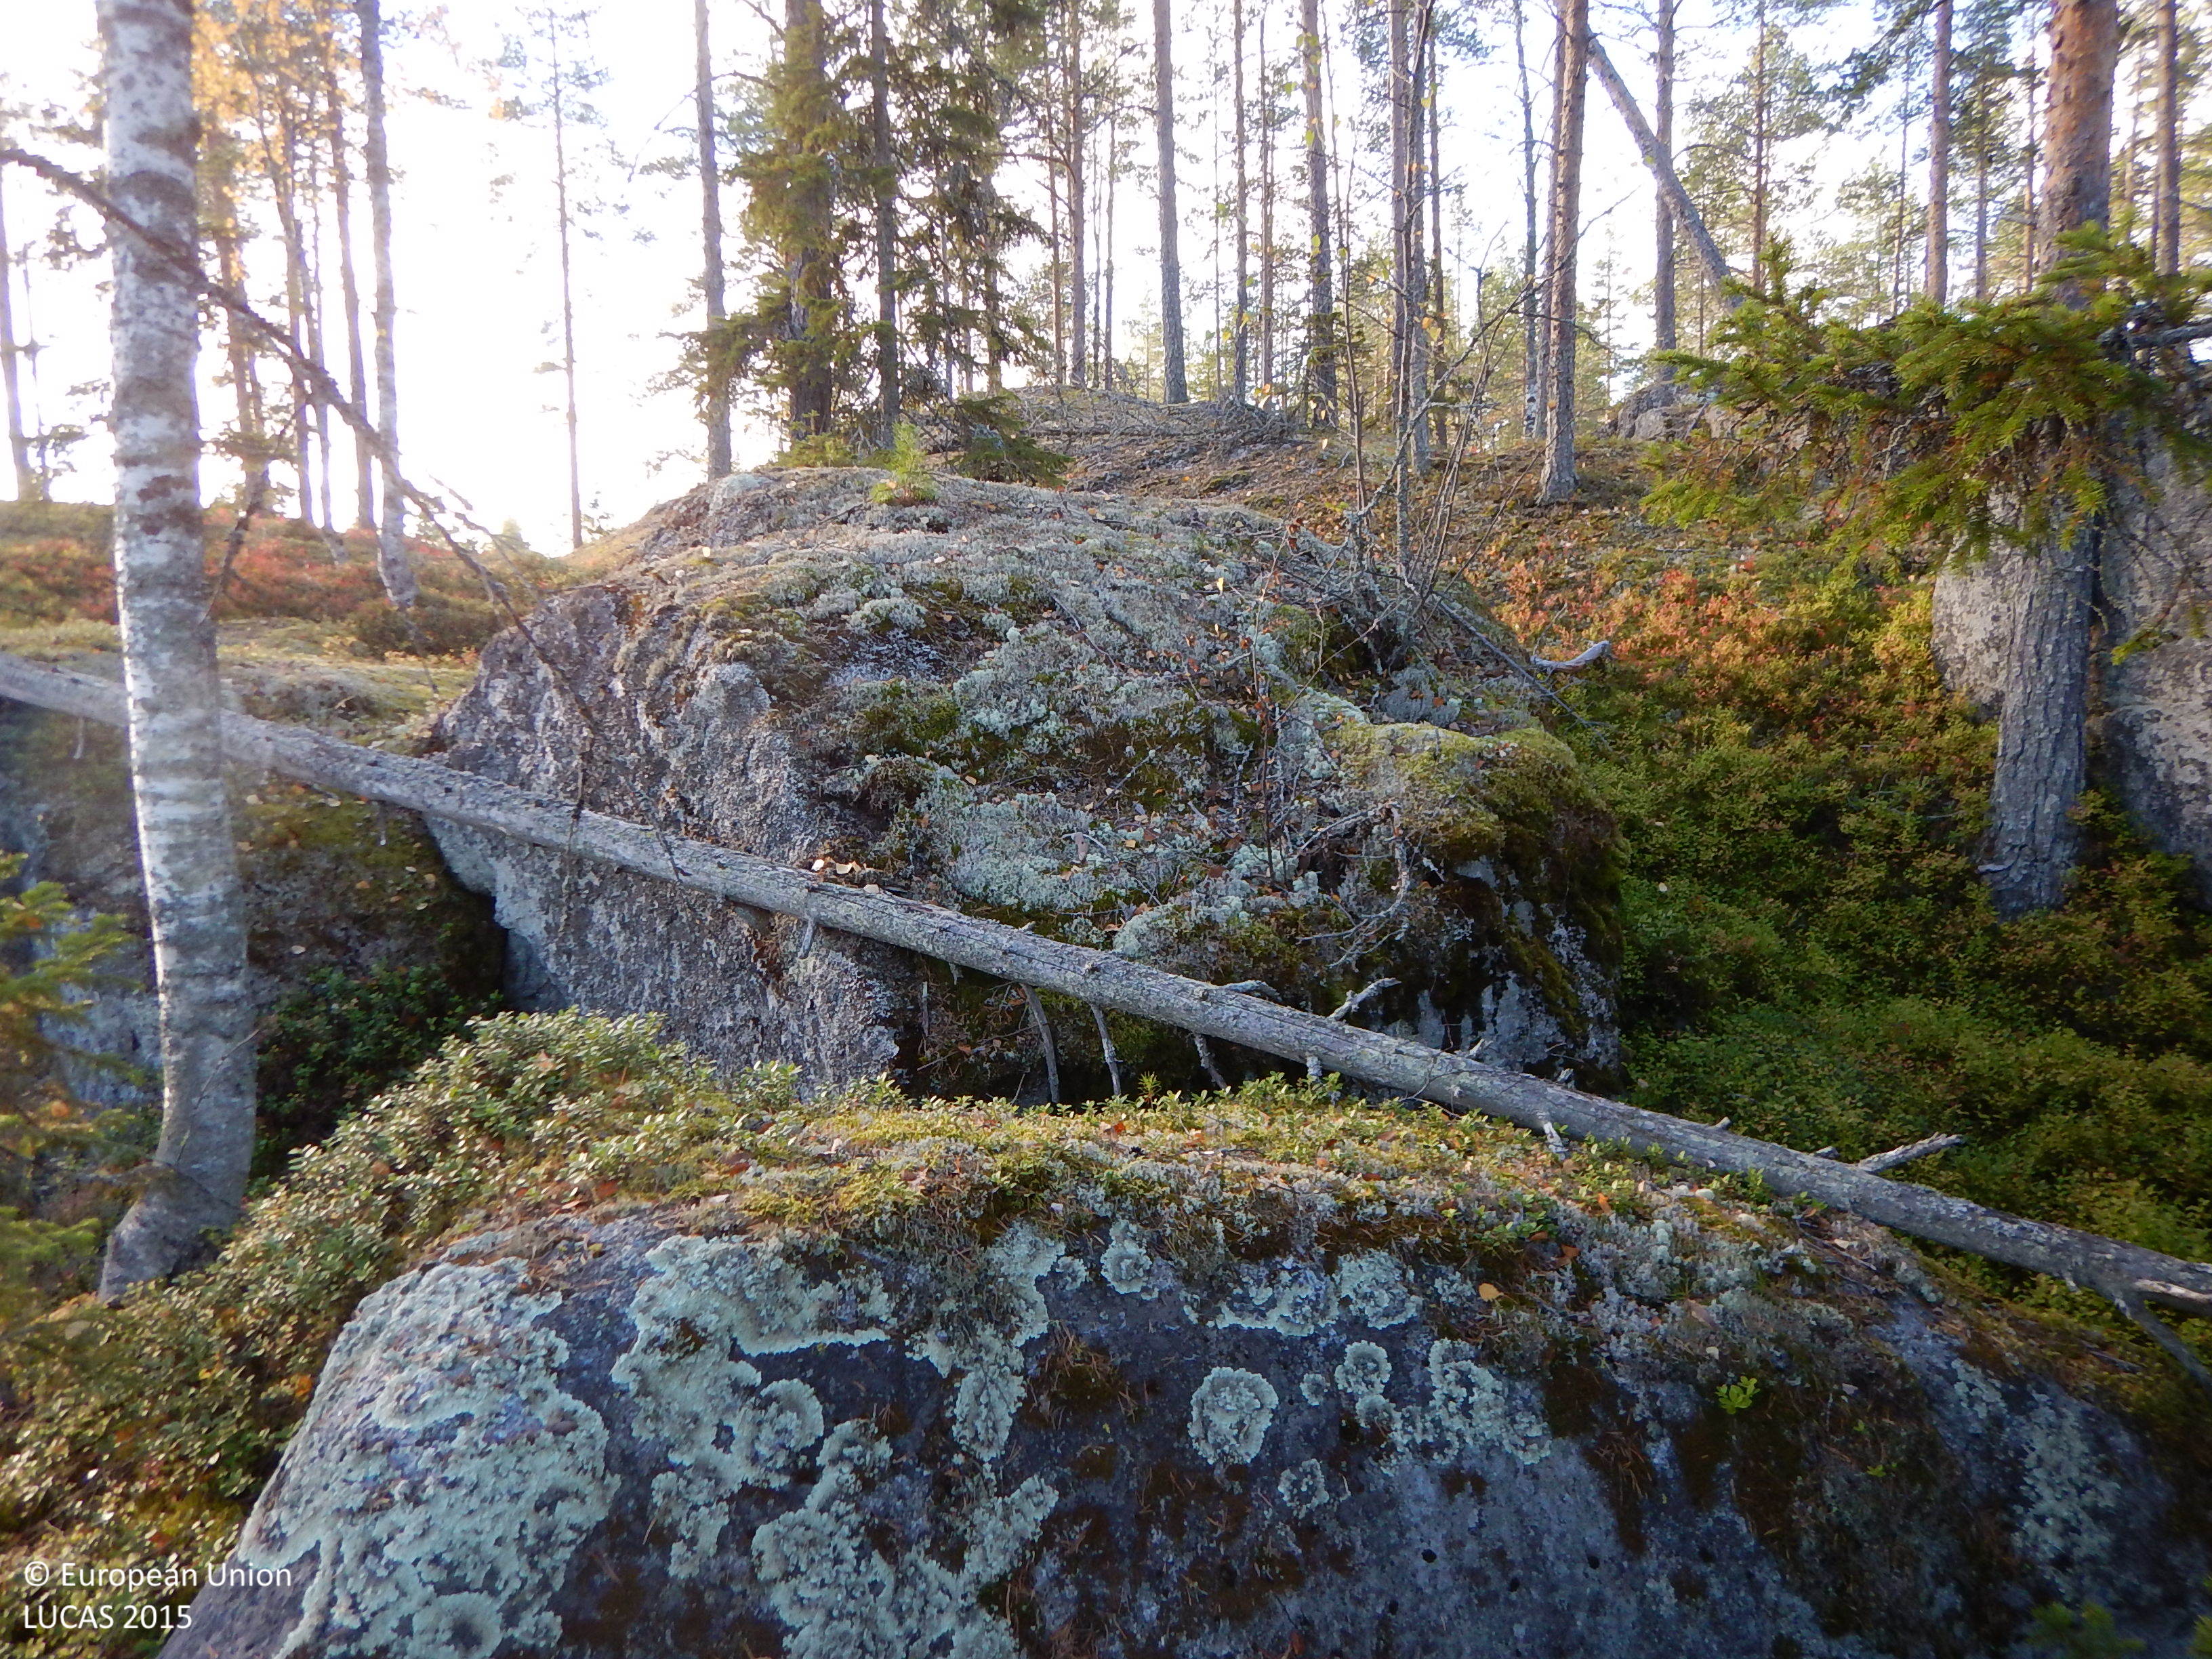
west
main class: Woodland
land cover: Other coniferous woodland
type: boreal forest
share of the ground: 50 - 75 %
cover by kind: coniferous forest trees 50 %, shrubs 20 %, lichens and mosses 20 %, herbaceous plants 5 %, consolidated bare surface 5 %
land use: Forestry
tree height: > 5 m
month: October
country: SE
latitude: 64.9167
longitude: 20.9057
